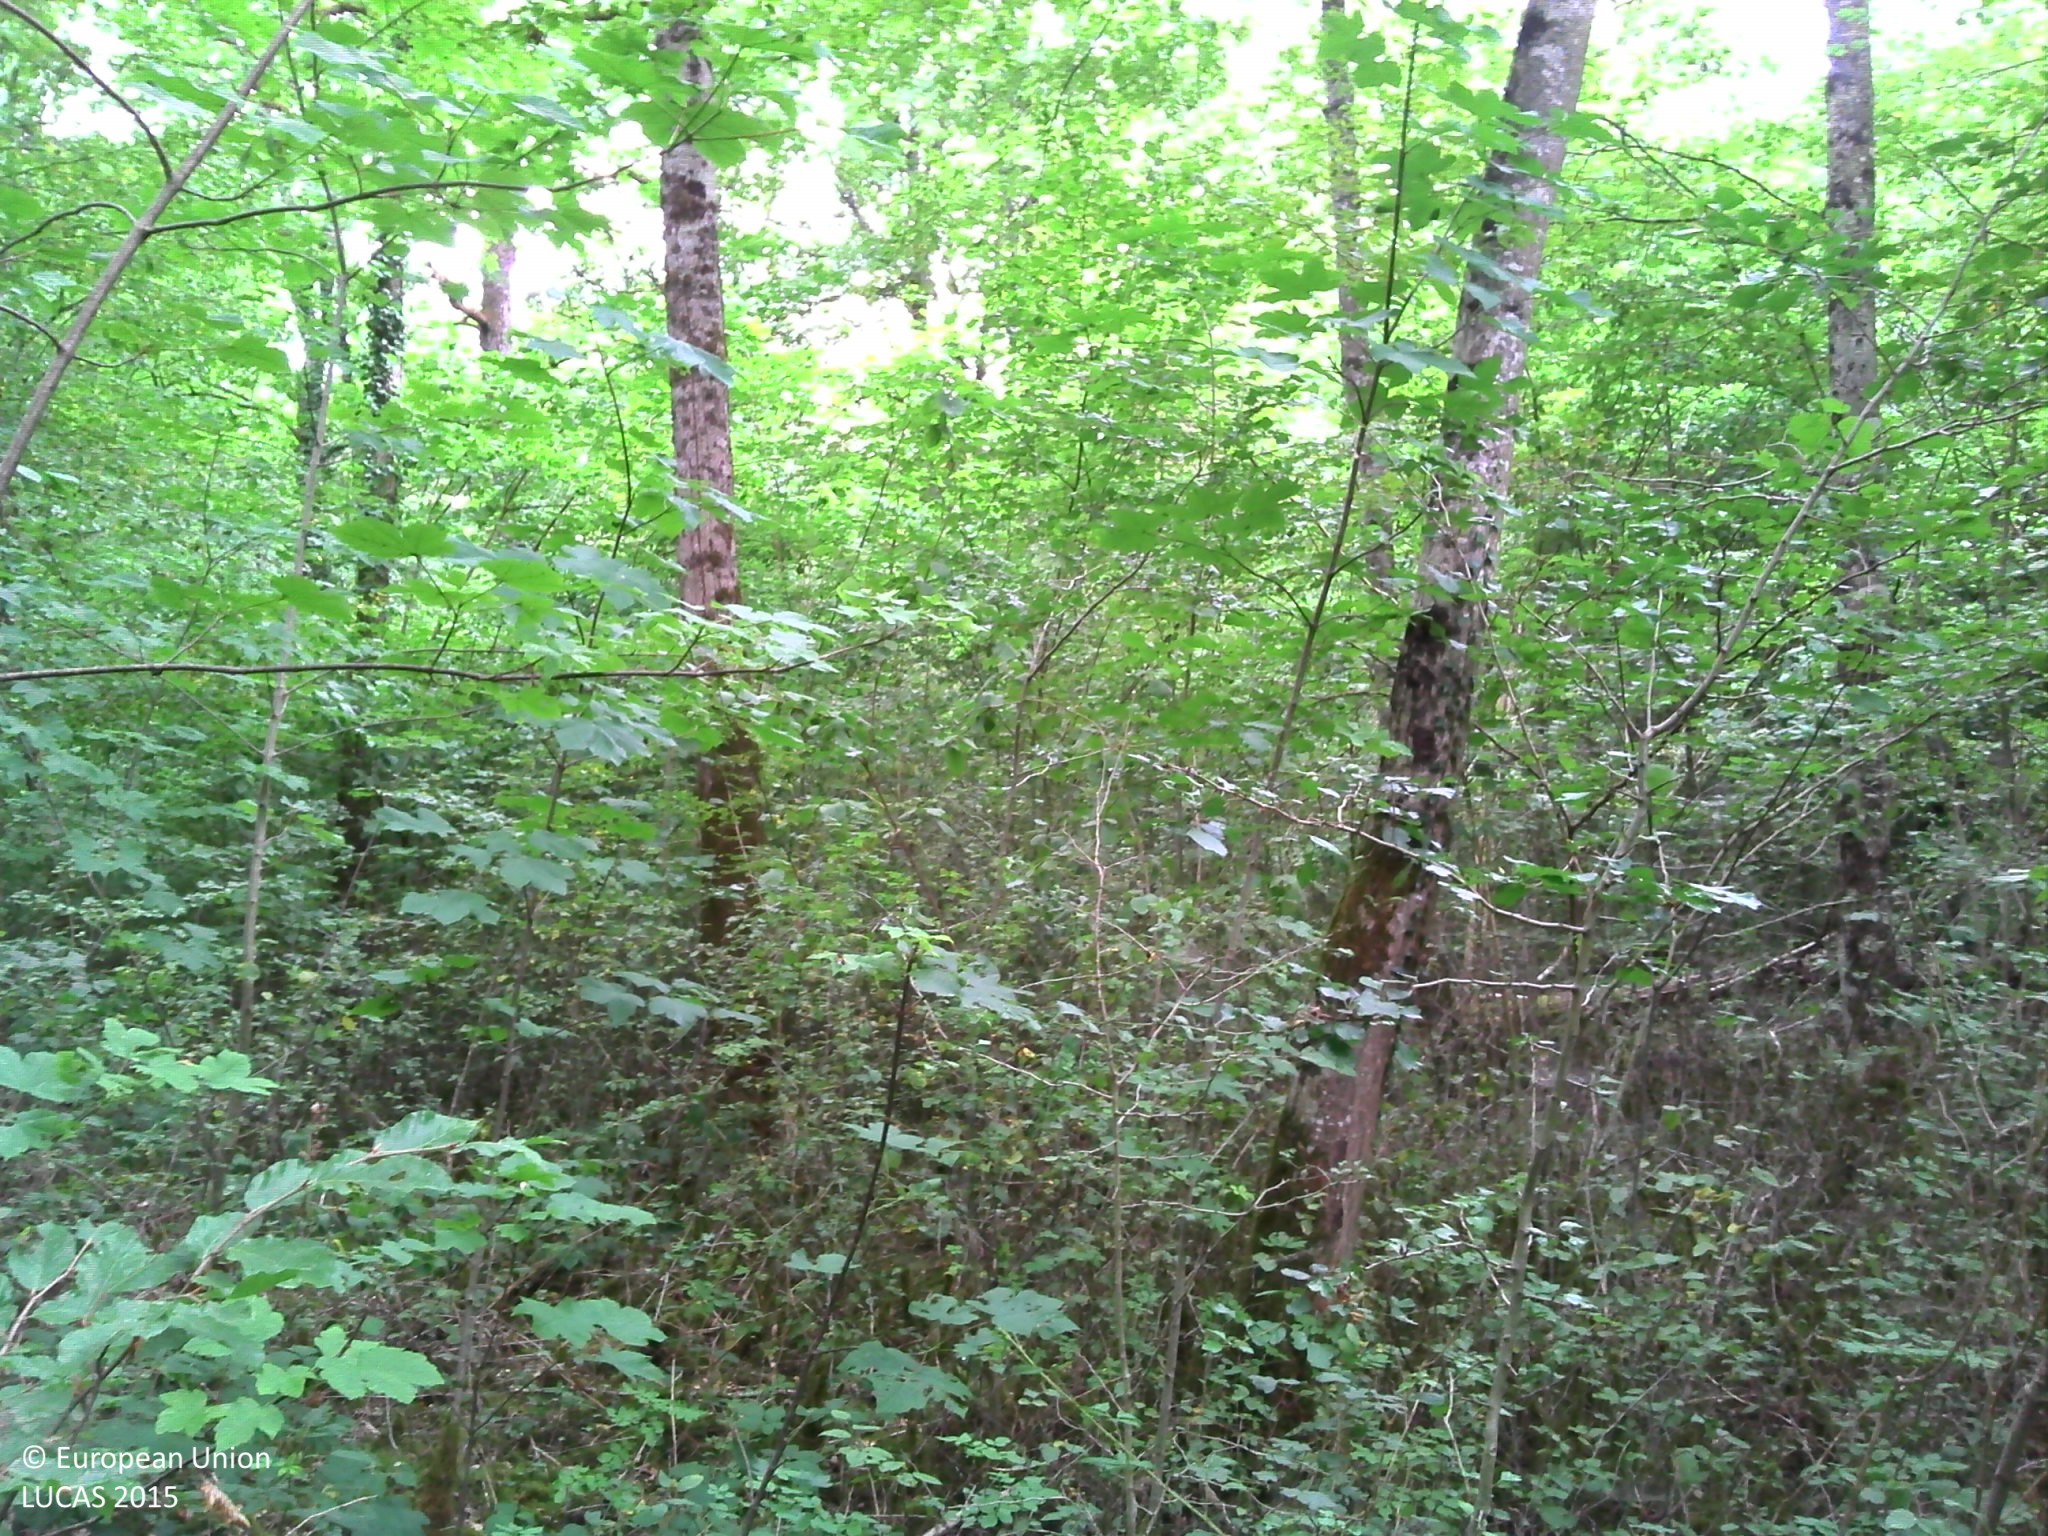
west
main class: Woodland
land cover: Broadleaved woodland
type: mesophytic deciduous forest
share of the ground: > 75 %
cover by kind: broadleaved forest trees 80 %, herbaceous plants 10 %, lichens and mosses 10 %
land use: Forestry
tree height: > 5 m
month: July
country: FR
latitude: 47.9767
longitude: 5.2438
